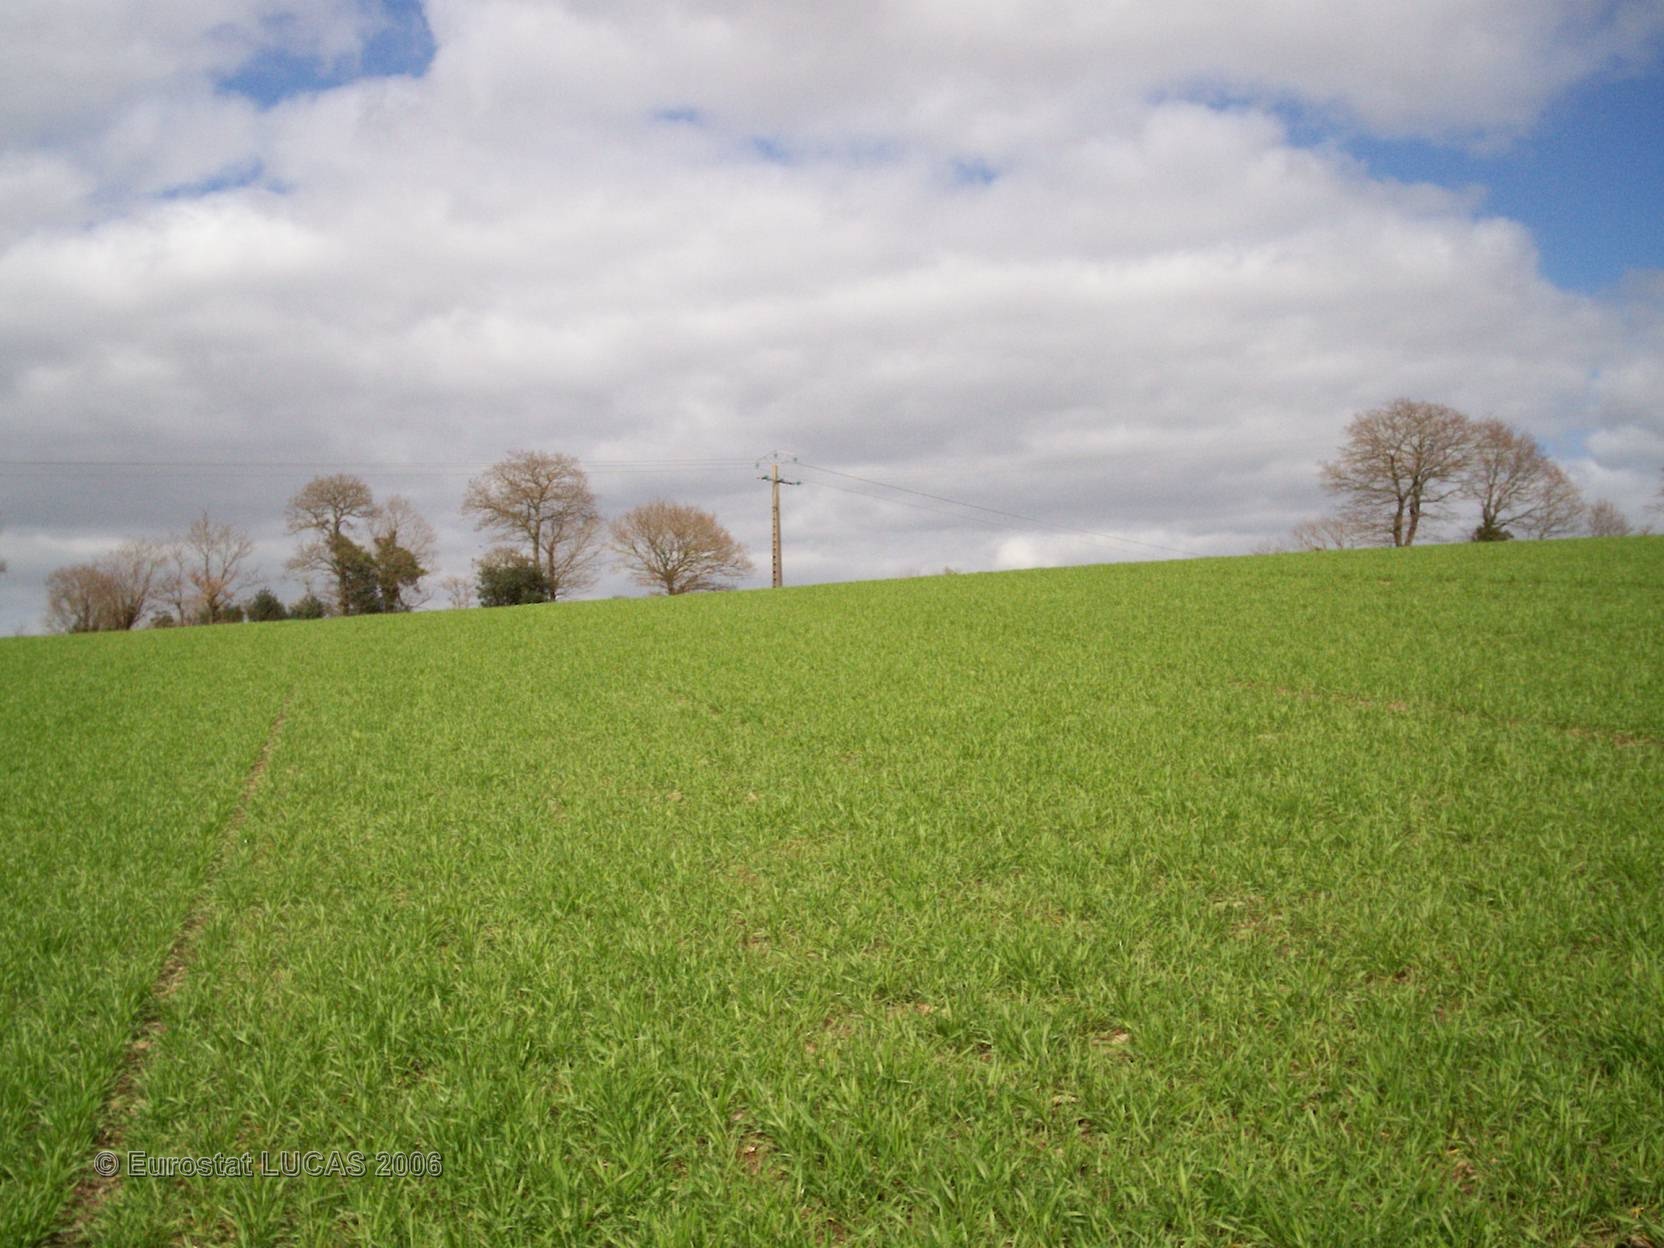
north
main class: Cropland
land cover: Common wheat
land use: Agriculture (excluding fallow land and kitchen gardens)
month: April
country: FR
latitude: 48.2178
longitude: -3.5788
